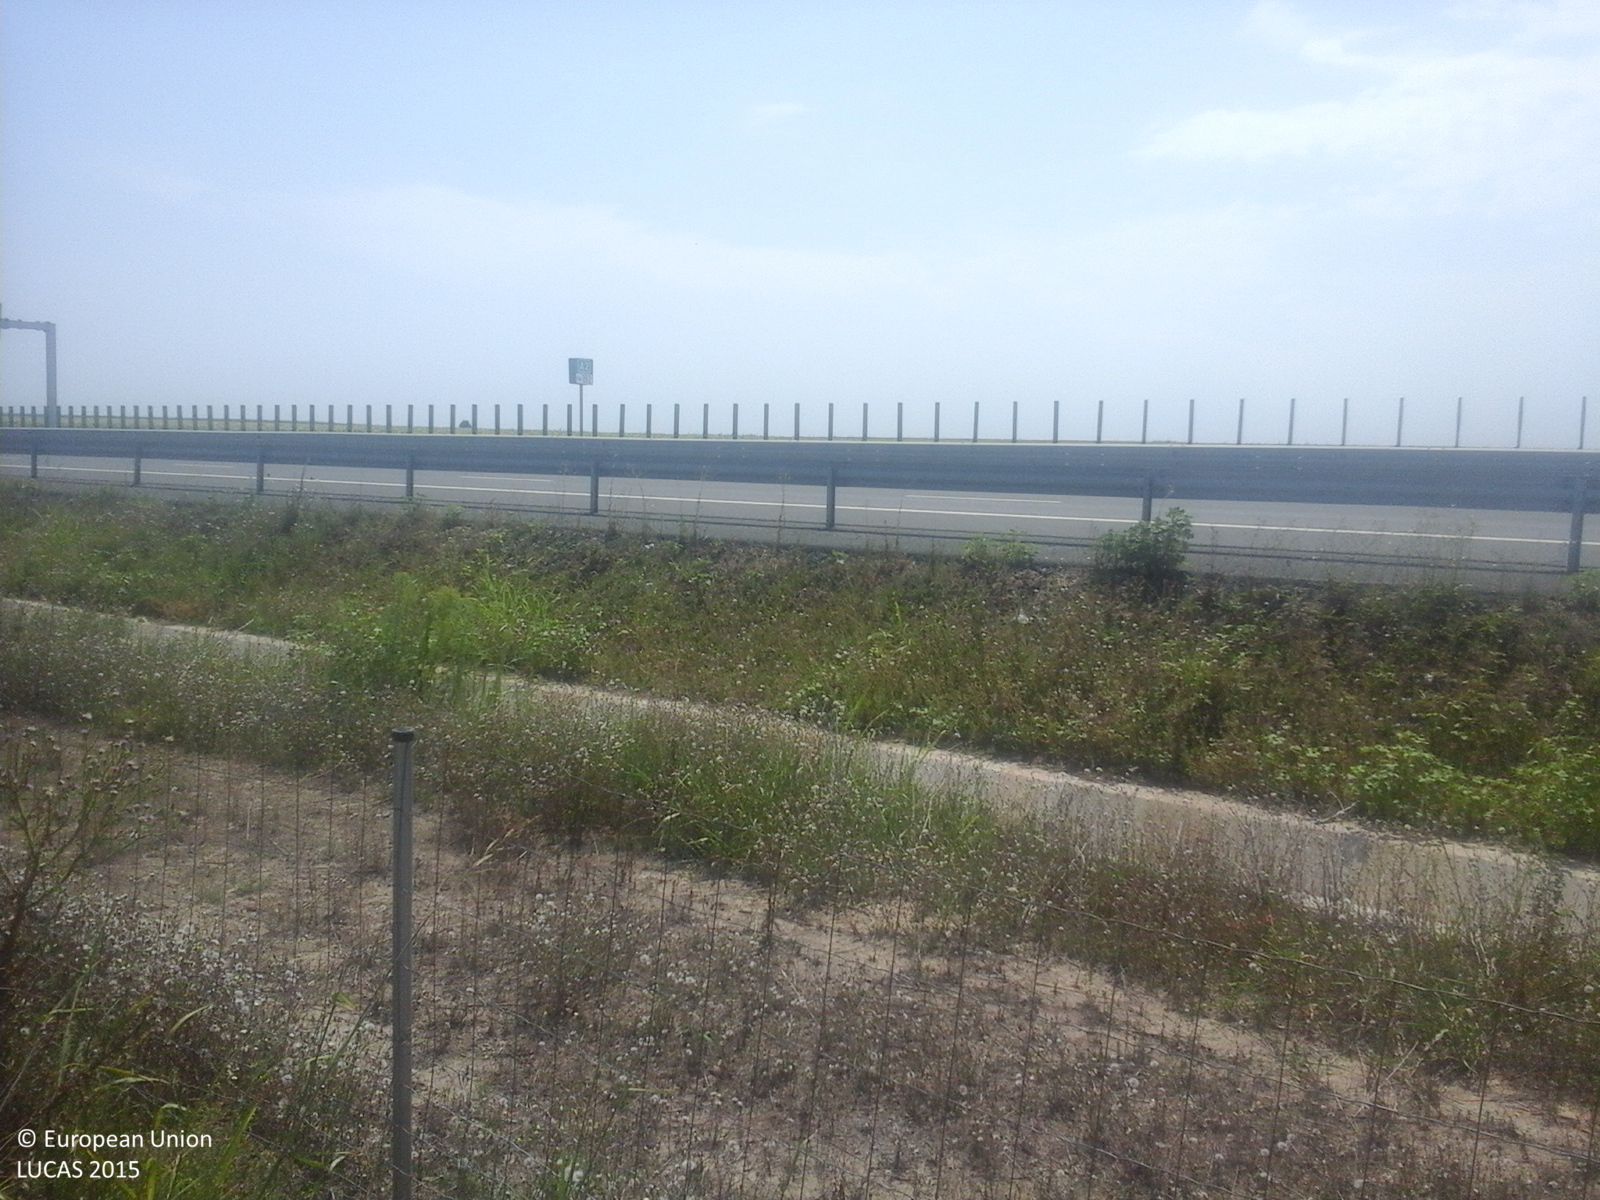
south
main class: Cropland
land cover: Sunflower
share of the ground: > 75 %
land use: Agriculture (excluding fallow land and kitchen gardens)
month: August
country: RO
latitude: 44.1801
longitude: 28.3141
